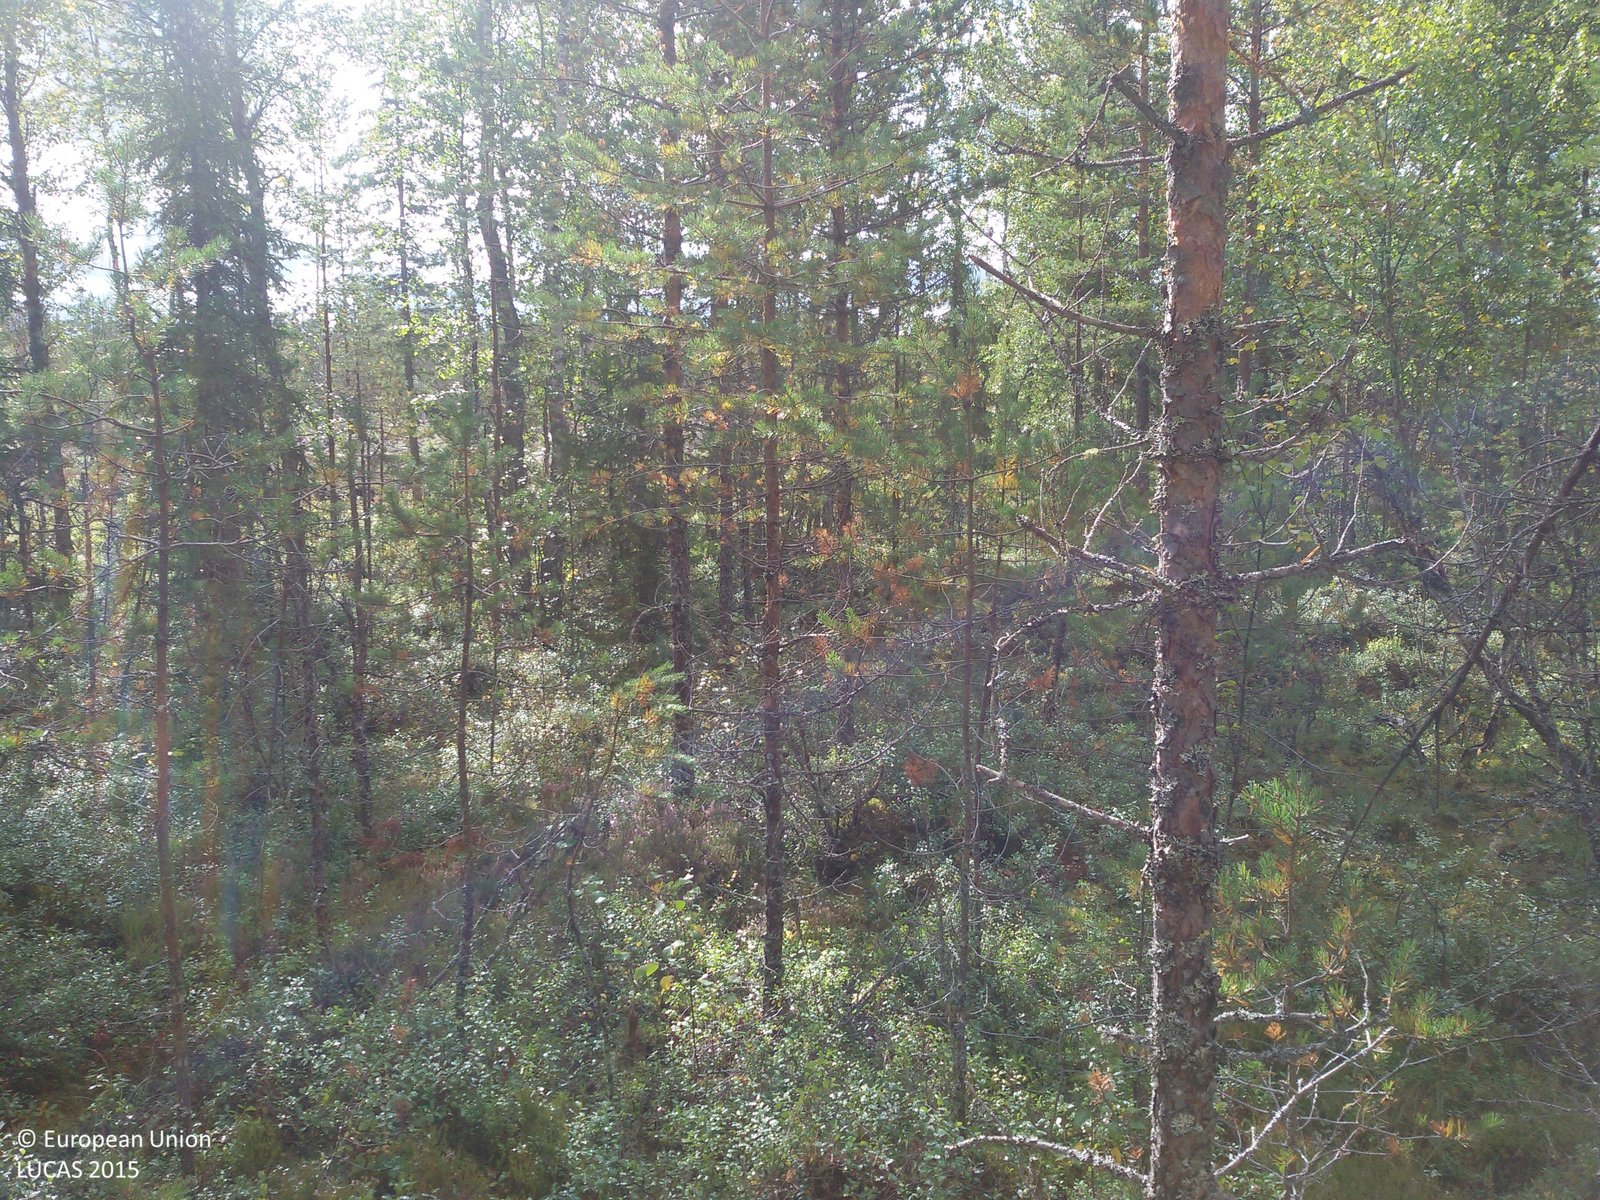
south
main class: Woodland
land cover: Pine dominated coniferous woodland
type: boreal forest
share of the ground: 50 - 75 %
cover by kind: coniferous forest trees 70 %, shrubs 15 %, lichens and mosses 15 %
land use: Forestry
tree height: > 5 m
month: September
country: SE
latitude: 61.0310
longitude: 15.4829
